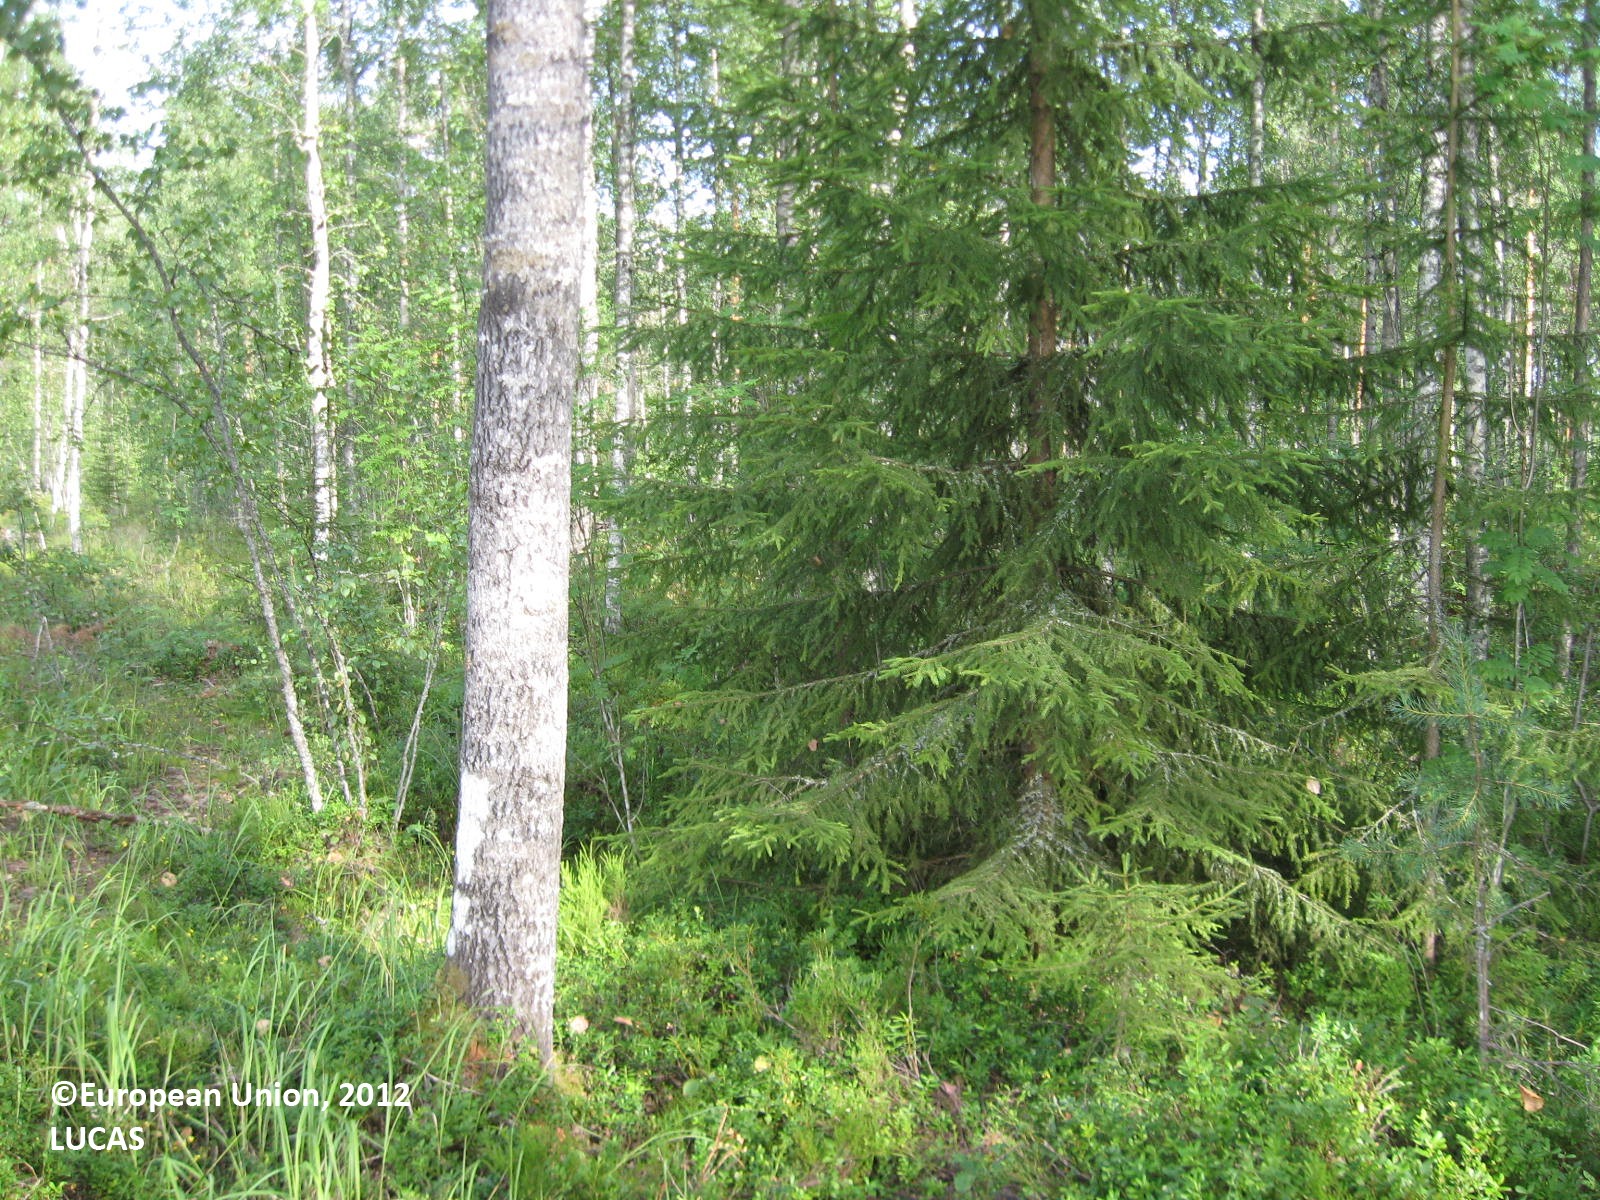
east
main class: Woodland
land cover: Other mixed woodland
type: boreal forest
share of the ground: > 75 %
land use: Forestry
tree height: > 5 m
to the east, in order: Other mixed woodland; Pine dominated mixed woodland; Ditches and canals; Other mixed woodland; Ditches and canals; Other mixed woodland
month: July
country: FI
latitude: 61.9231
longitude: 22.7290
